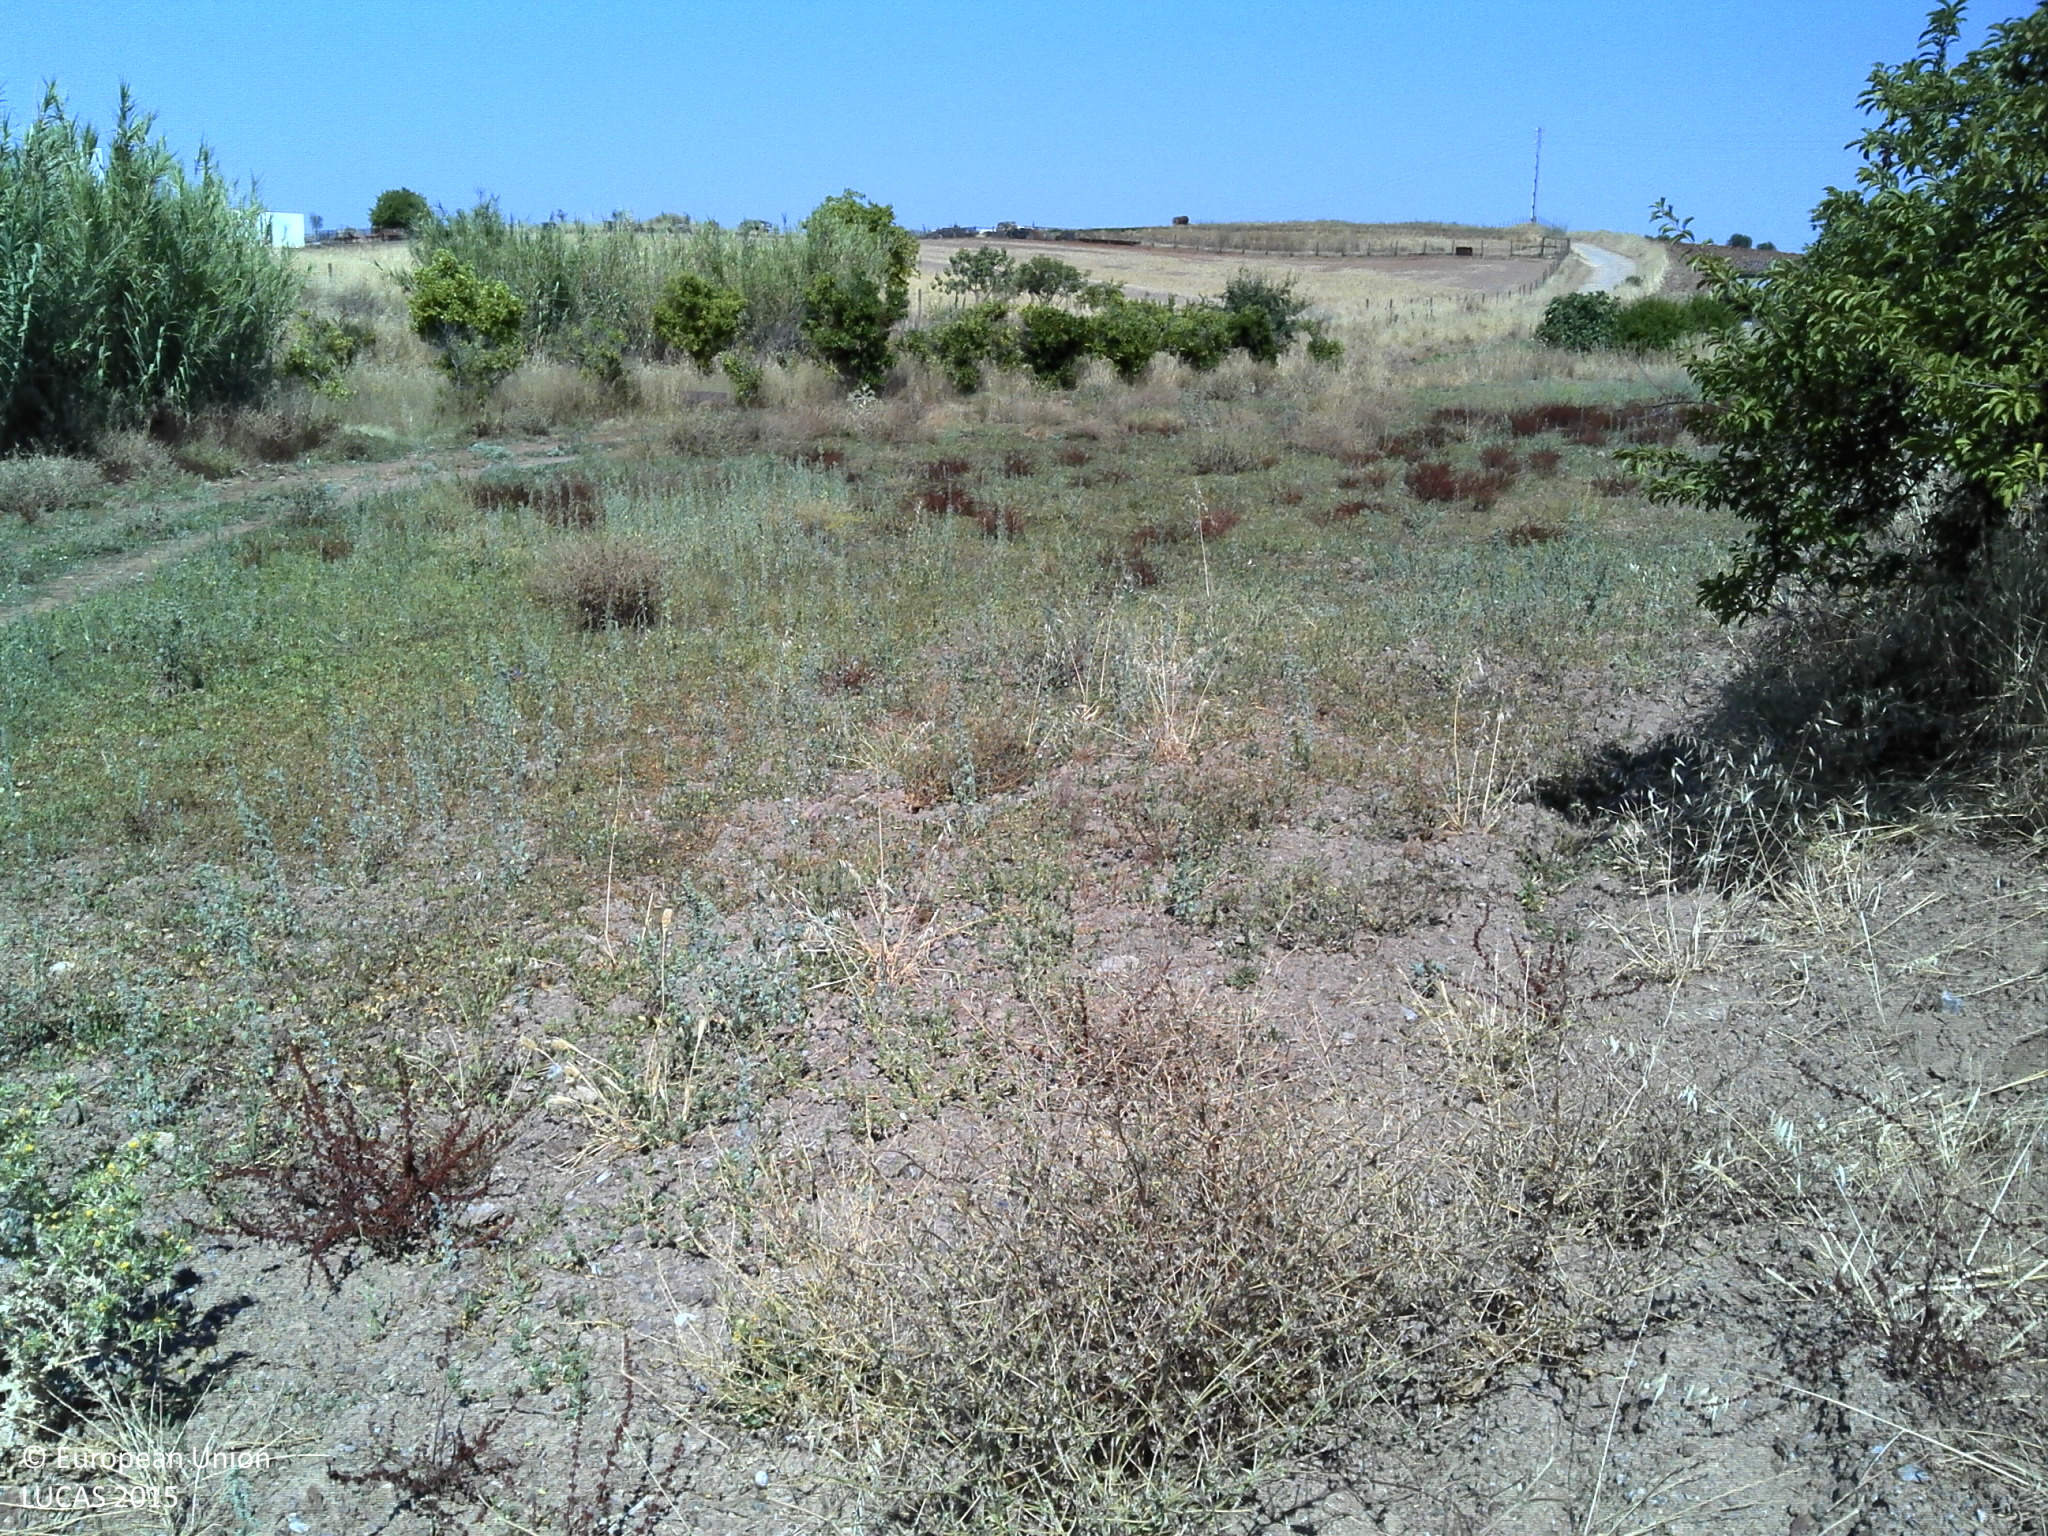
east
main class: Cropland
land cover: Nuts trees
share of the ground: 10 - 25 %
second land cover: Grassland without tree/shrub cover
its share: 25 - 50 %
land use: Agriculture (excluding fallow land and kitchen gardens)
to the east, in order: Nuts trees; Grassland without tree/shrub cover; Ditches and canals; Grass margins; Tracks; Oranges; Grassland without tree/shrub cover; Ditches and canals; Grass margins; Fences; Grass margins; Tracks; Grass margins; Fences; Grassland without tree/shrub cover; Fences; Grassland without tree/shrub cover; Fences; Grass margins; Tracks; Fences; Spontaneously vegetated surfaces
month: June
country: PT
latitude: 38.0336
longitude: -7.6017
